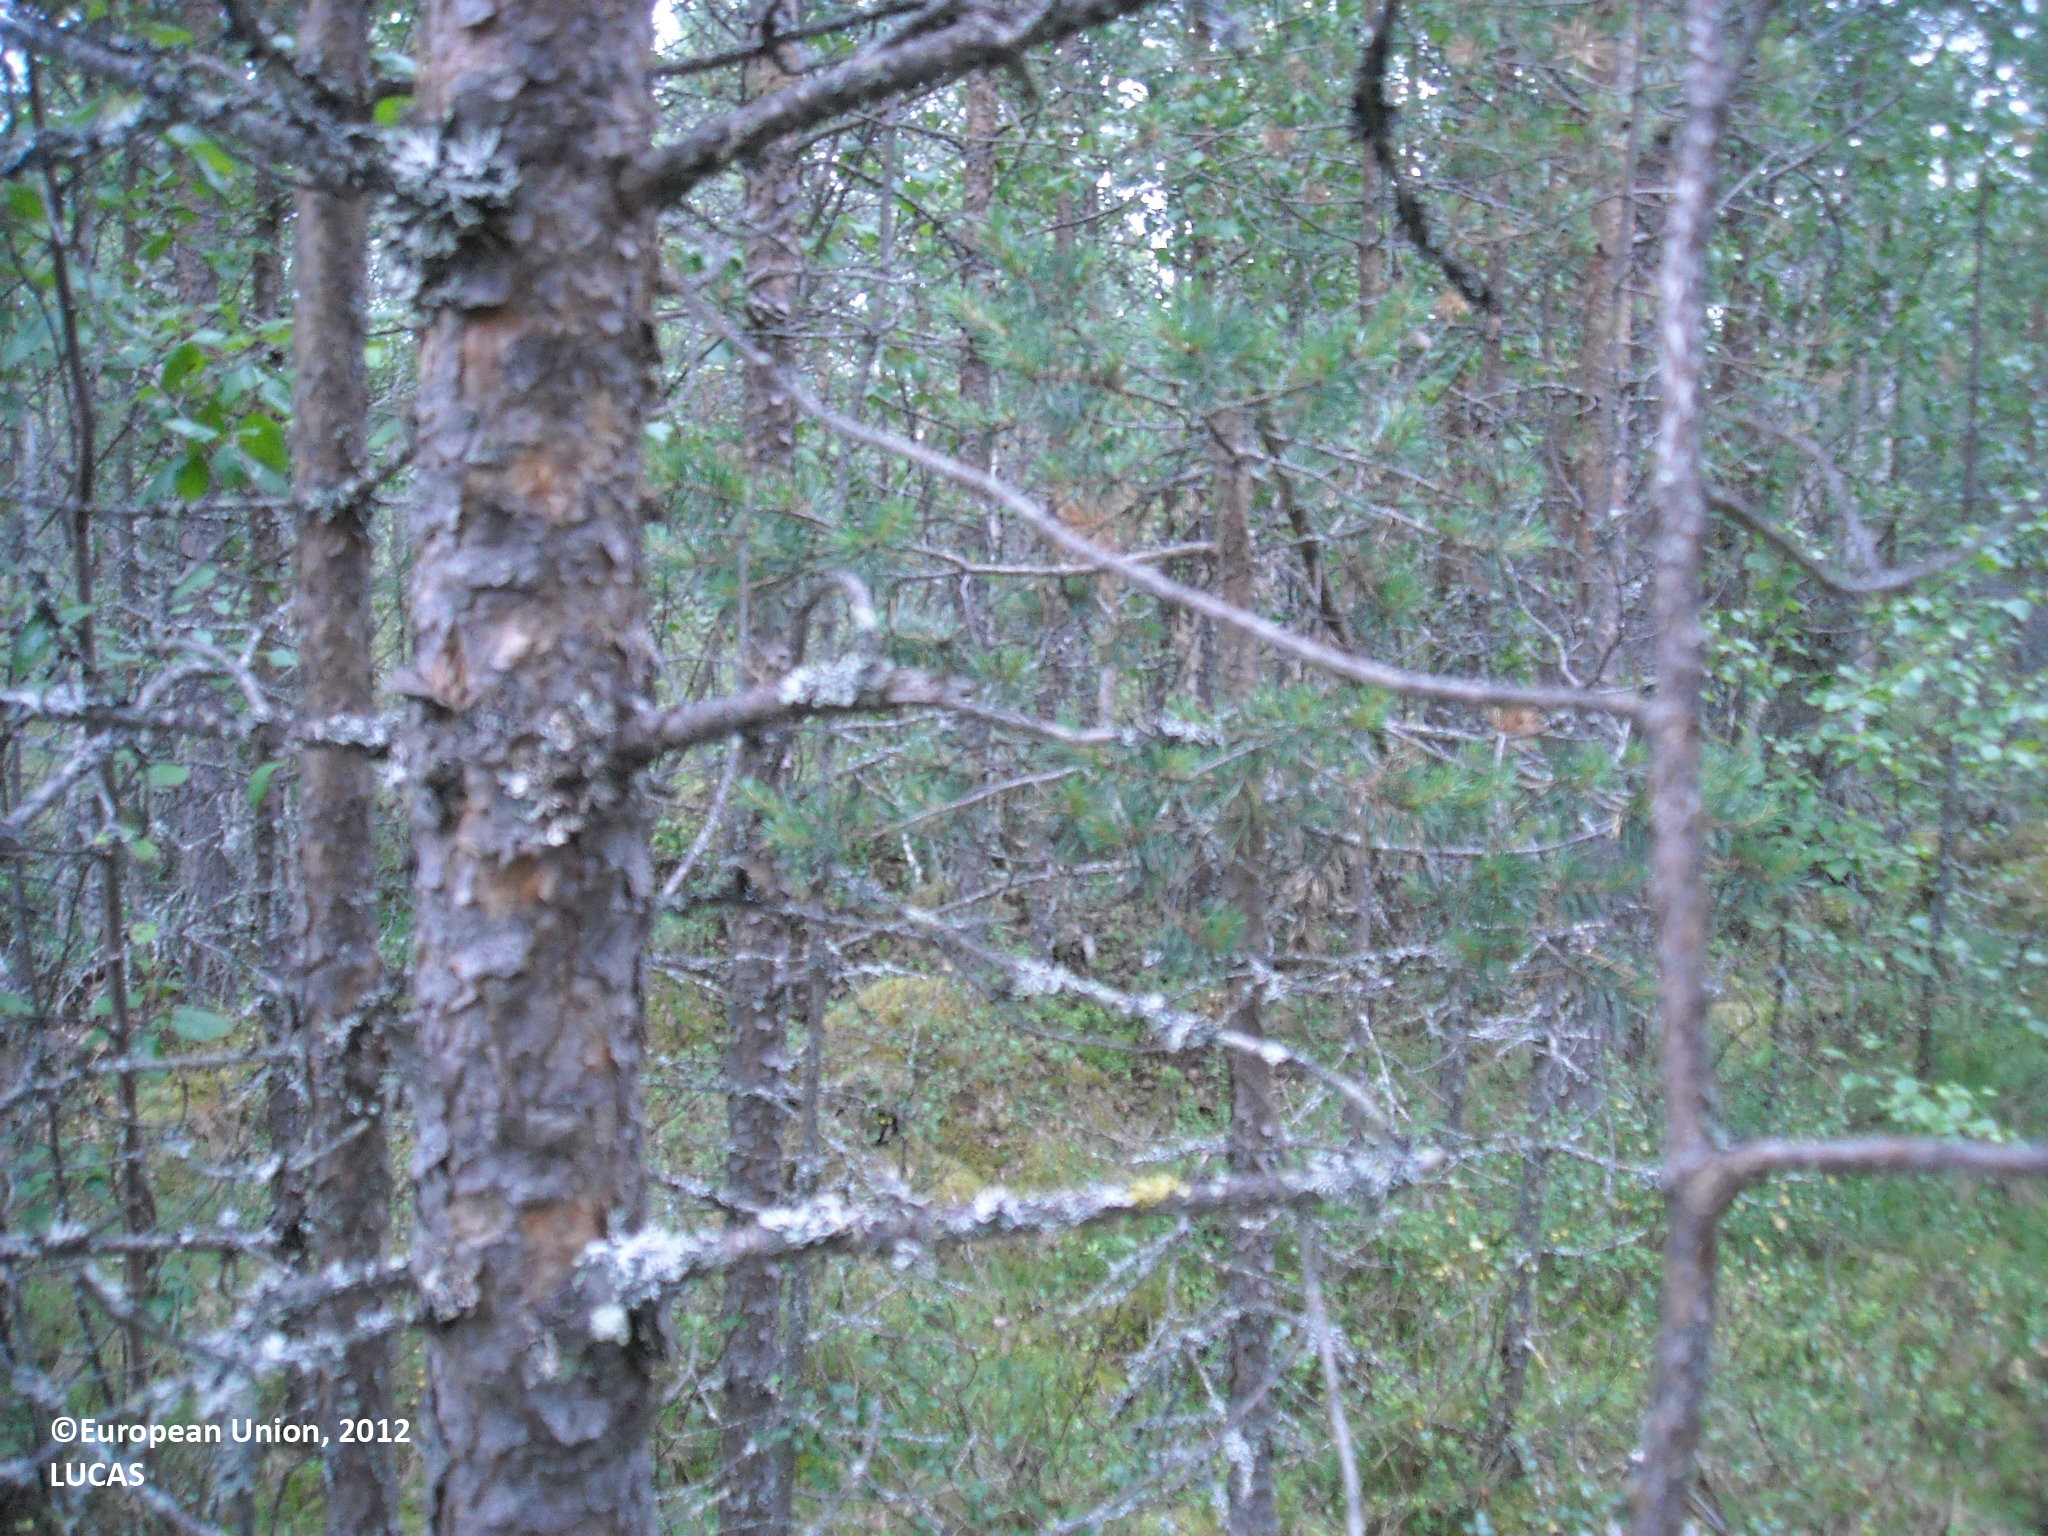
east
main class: Woodland
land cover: Pine dominated mixed woodland
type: mire and swamp forests
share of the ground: > 75 %
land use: Forestry
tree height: > 5 m
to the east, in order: Pine dominated mixed woodland; Ditches and canals; Pine dominated mixed woodland; Ditches and canals; Pine dominated coniferous woodland; Pine dominated mixed woodland; Ditches and canals; Pine dominated mixed woodland; Ditches and canals; Pine dominated mixed woodland; Ditches and canals; Pine dominated coniferous woodland; Ditches and canals; Pine dominated coniferous woodland; Pine dominated mixed woodland; Ditches and canals; Pine dominated mixed woodland; Ditches and canals; Pine dominated mixed woodland
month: July
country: FI
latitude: 64.9179
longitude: 26.8415
